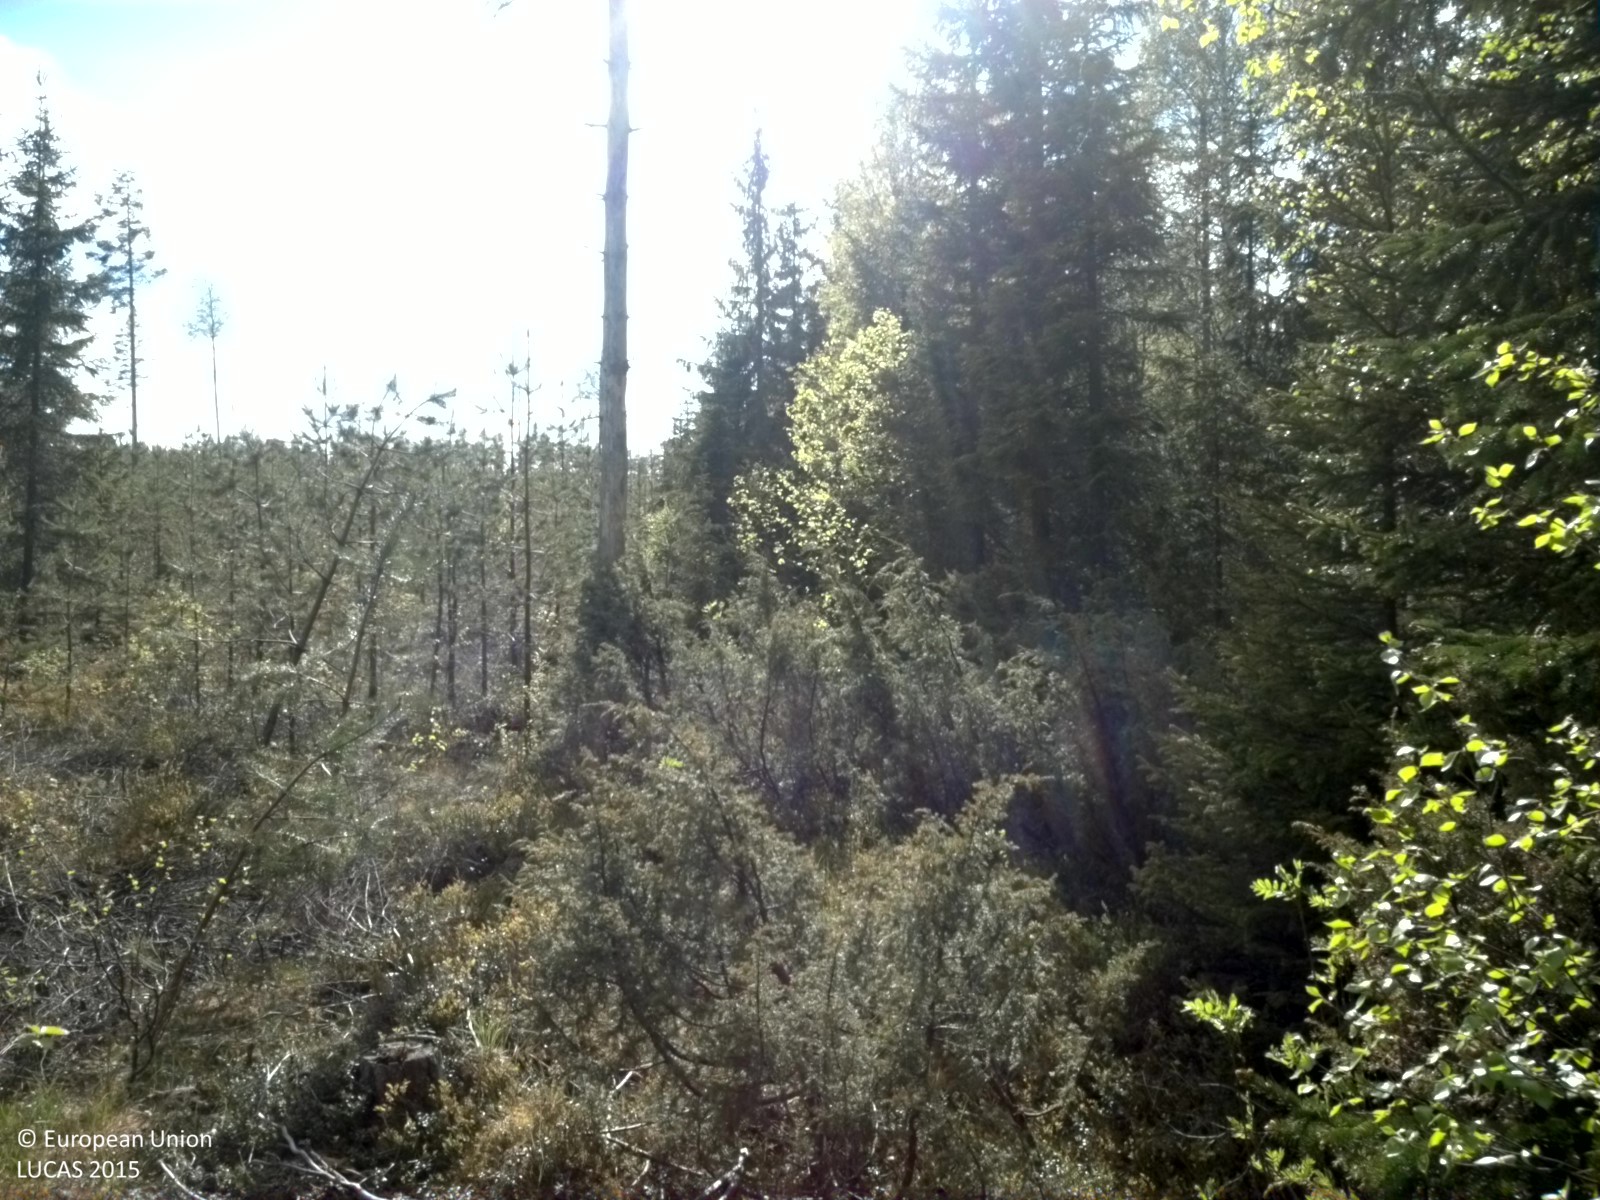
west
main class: Woodland
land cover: Spruce dominated mixed woodland
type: boreal forest
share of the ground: 50 - 75 %
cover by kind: herbaceous plants 50 %, coniferous forest trees 30 %, broadleaved forest trees 20 %
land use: Forestry
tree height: > 5 m
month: June
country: SE
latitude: 63.9490
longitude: 20.0819
